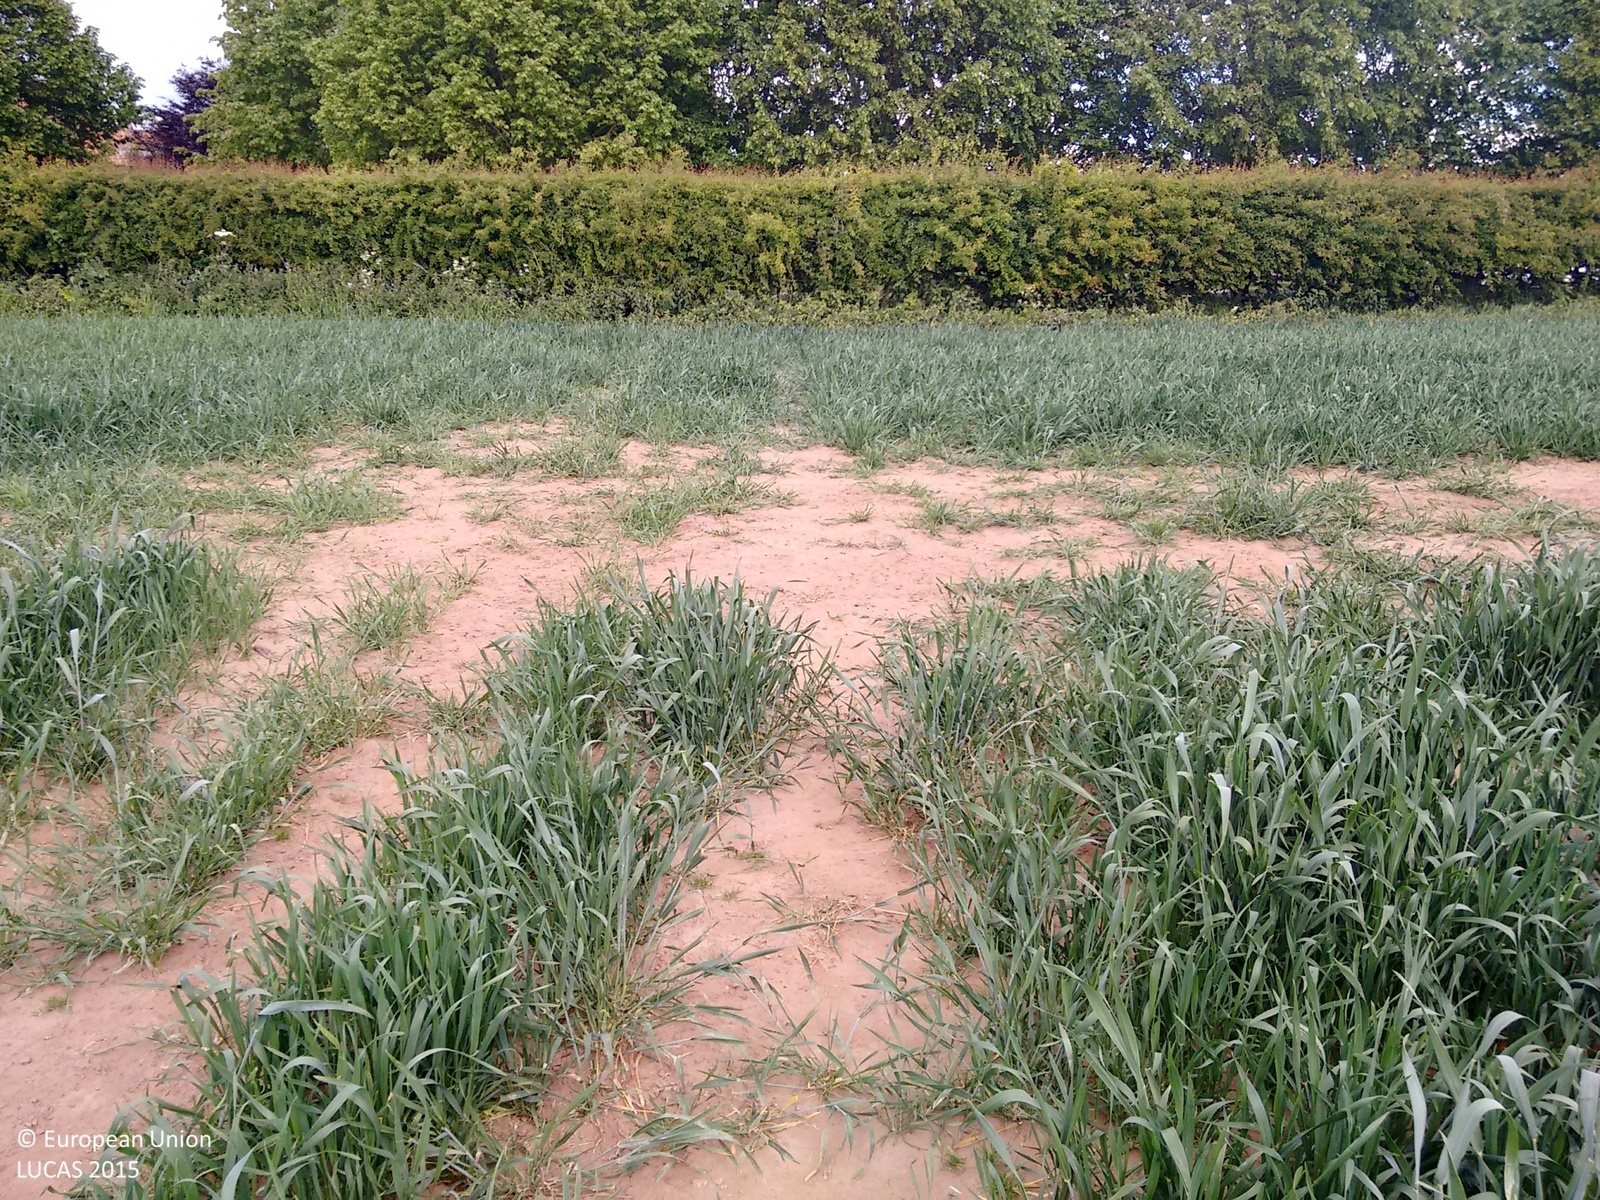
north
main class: Cropland
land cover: Common wheat
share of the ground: > 75 %
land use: Agriculture (excluding fallow land and kitchen gardens)
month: June
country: GB
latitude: 54.2405
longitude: -1.4179
